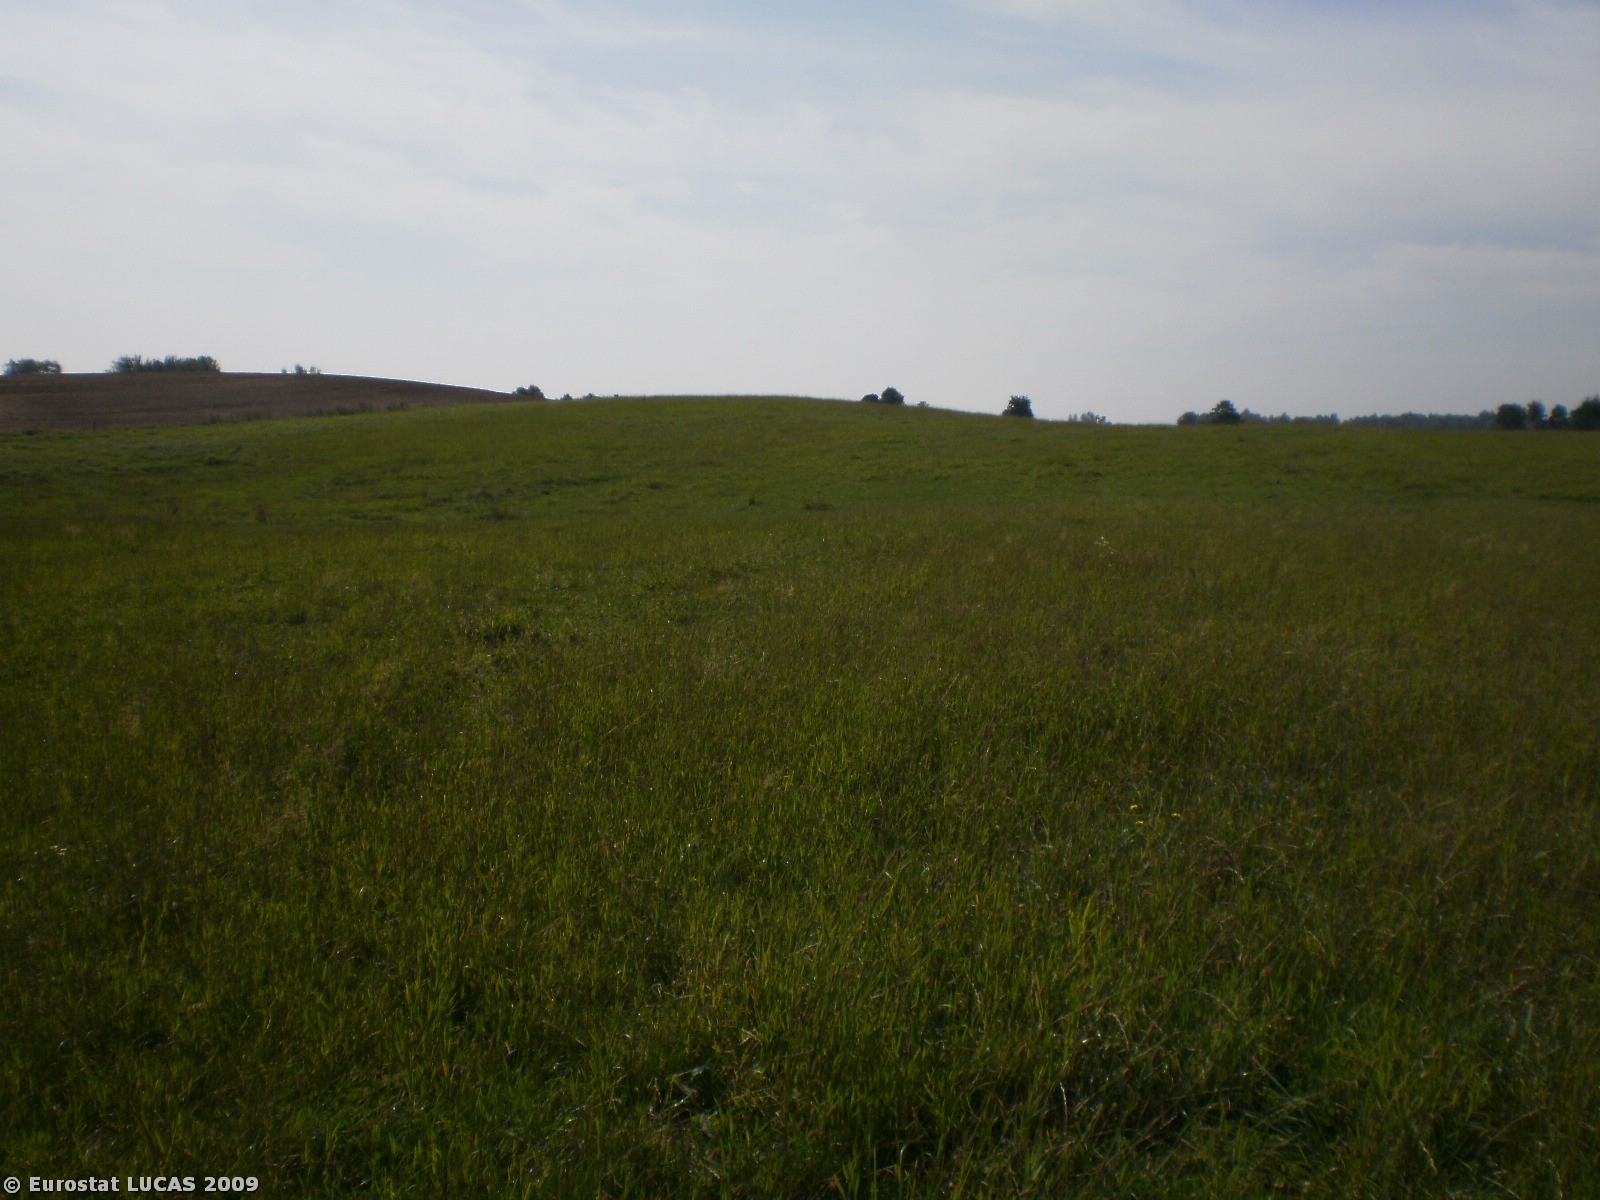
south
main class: Grassland
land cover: Grassland without tree/shrub cover
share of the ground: > 75 %
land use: Agriculture (excluding fallow land and kitchen gardens)
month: August
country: PL
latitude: 53.9937
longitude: 21.7214
